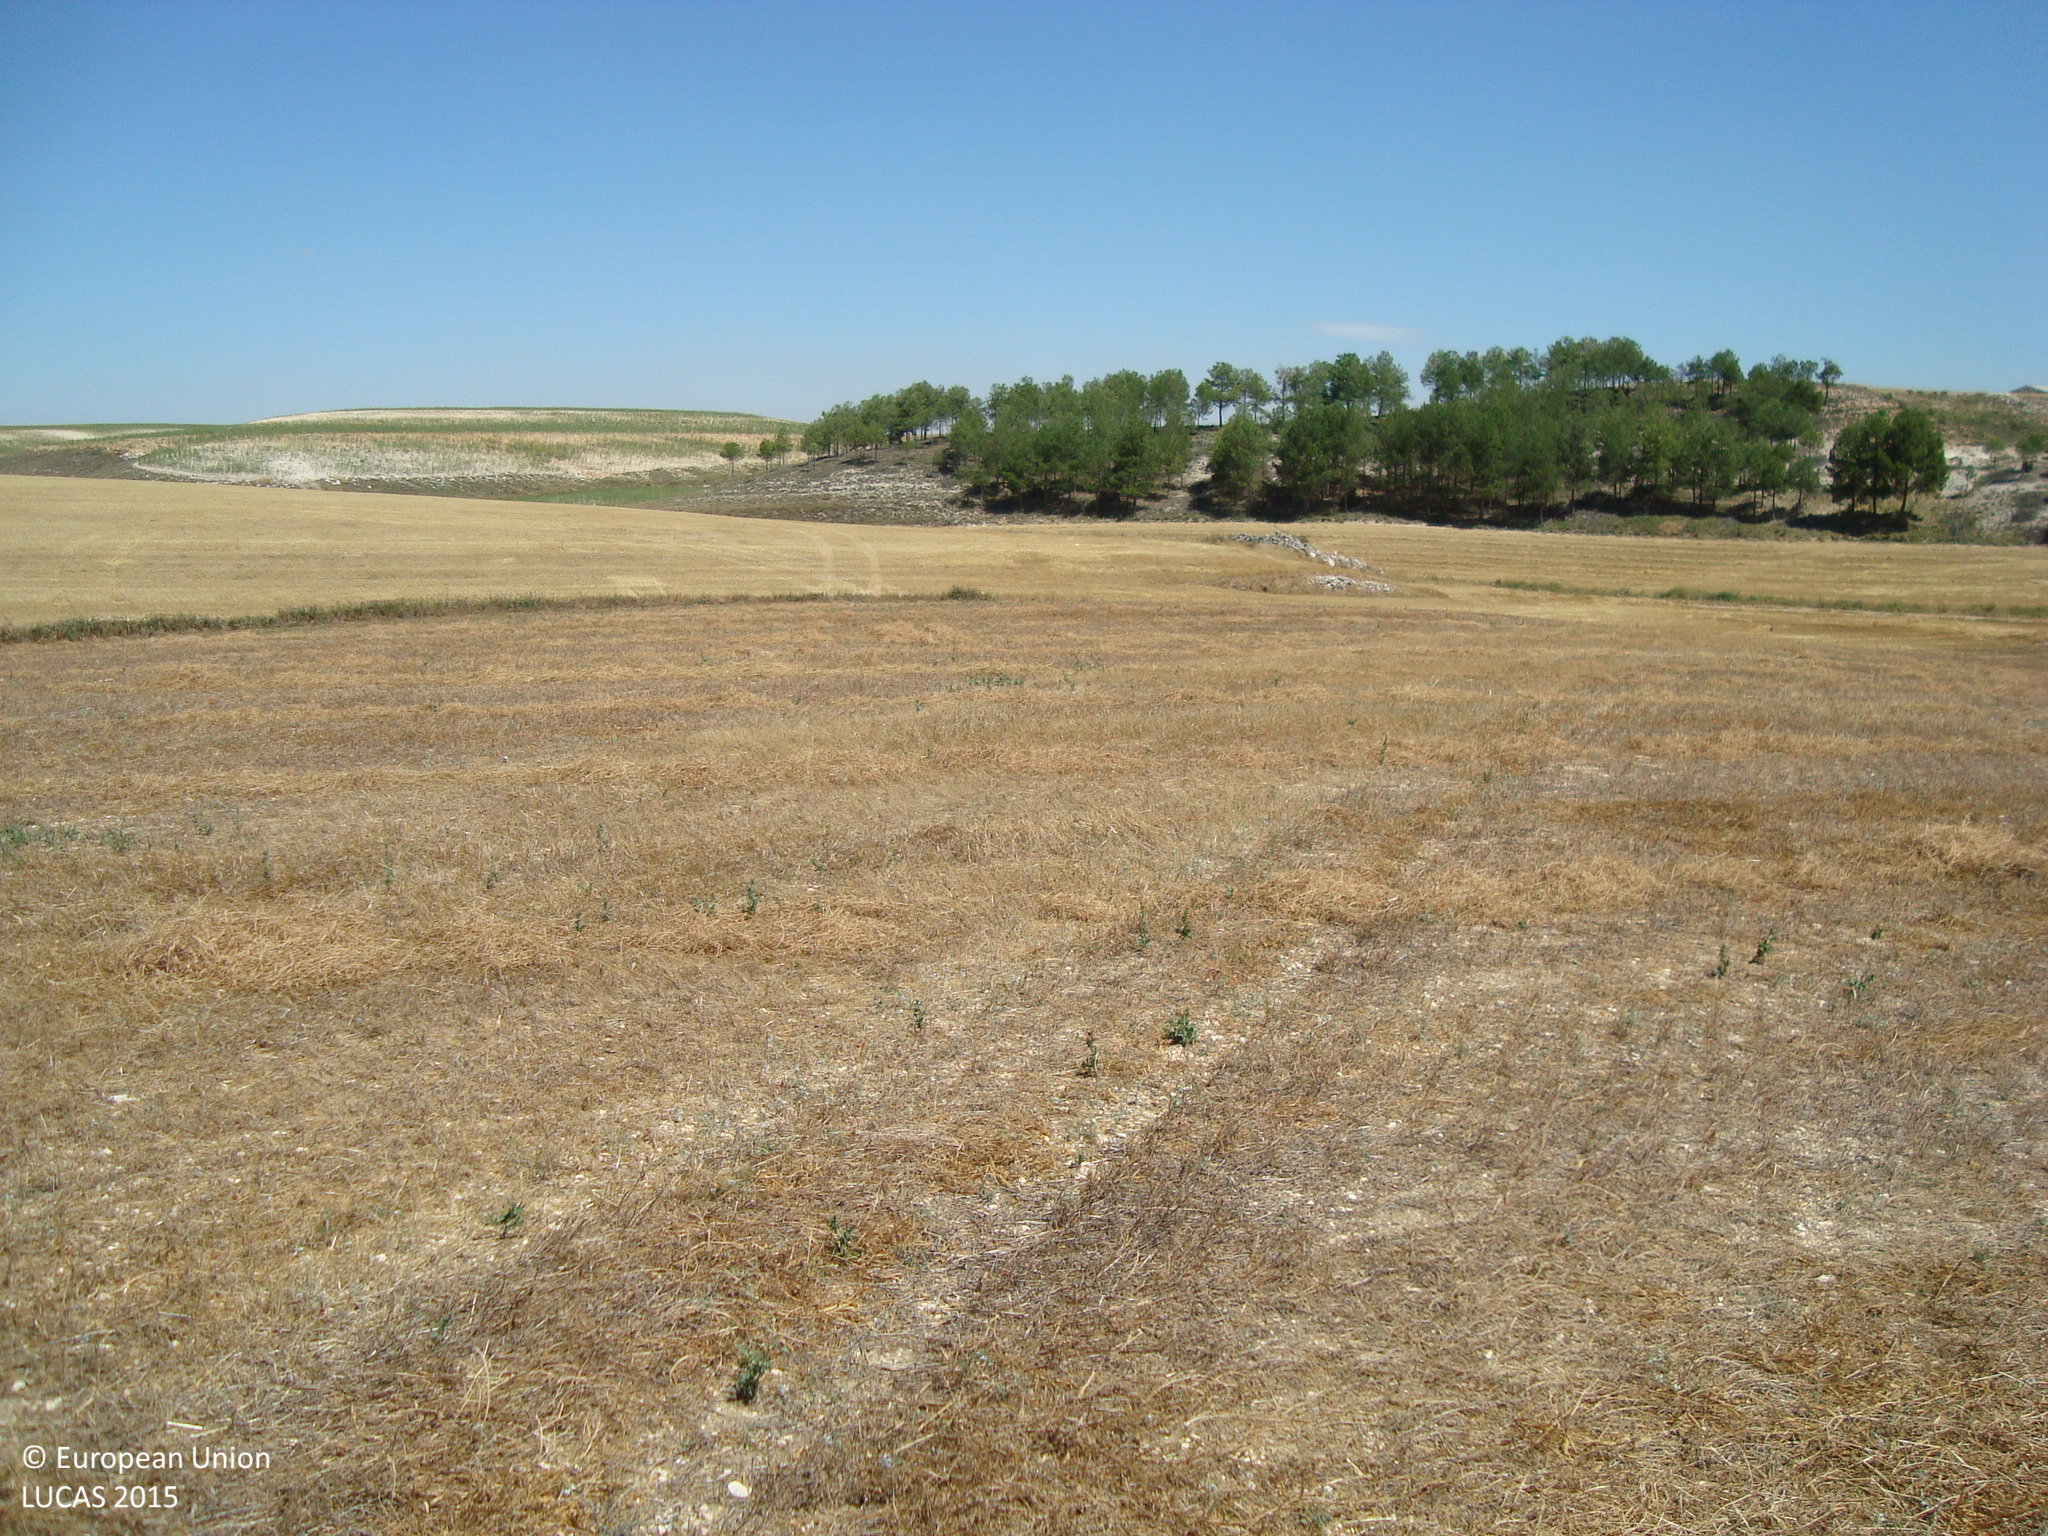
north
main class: Cropland
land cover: Dry pulses
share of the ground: > 75 %
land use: Agriculture (excluding fallow land and kitchen gardens)
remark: Harvested field
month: July
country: ES
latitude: 41.8862
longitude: -3.8076
